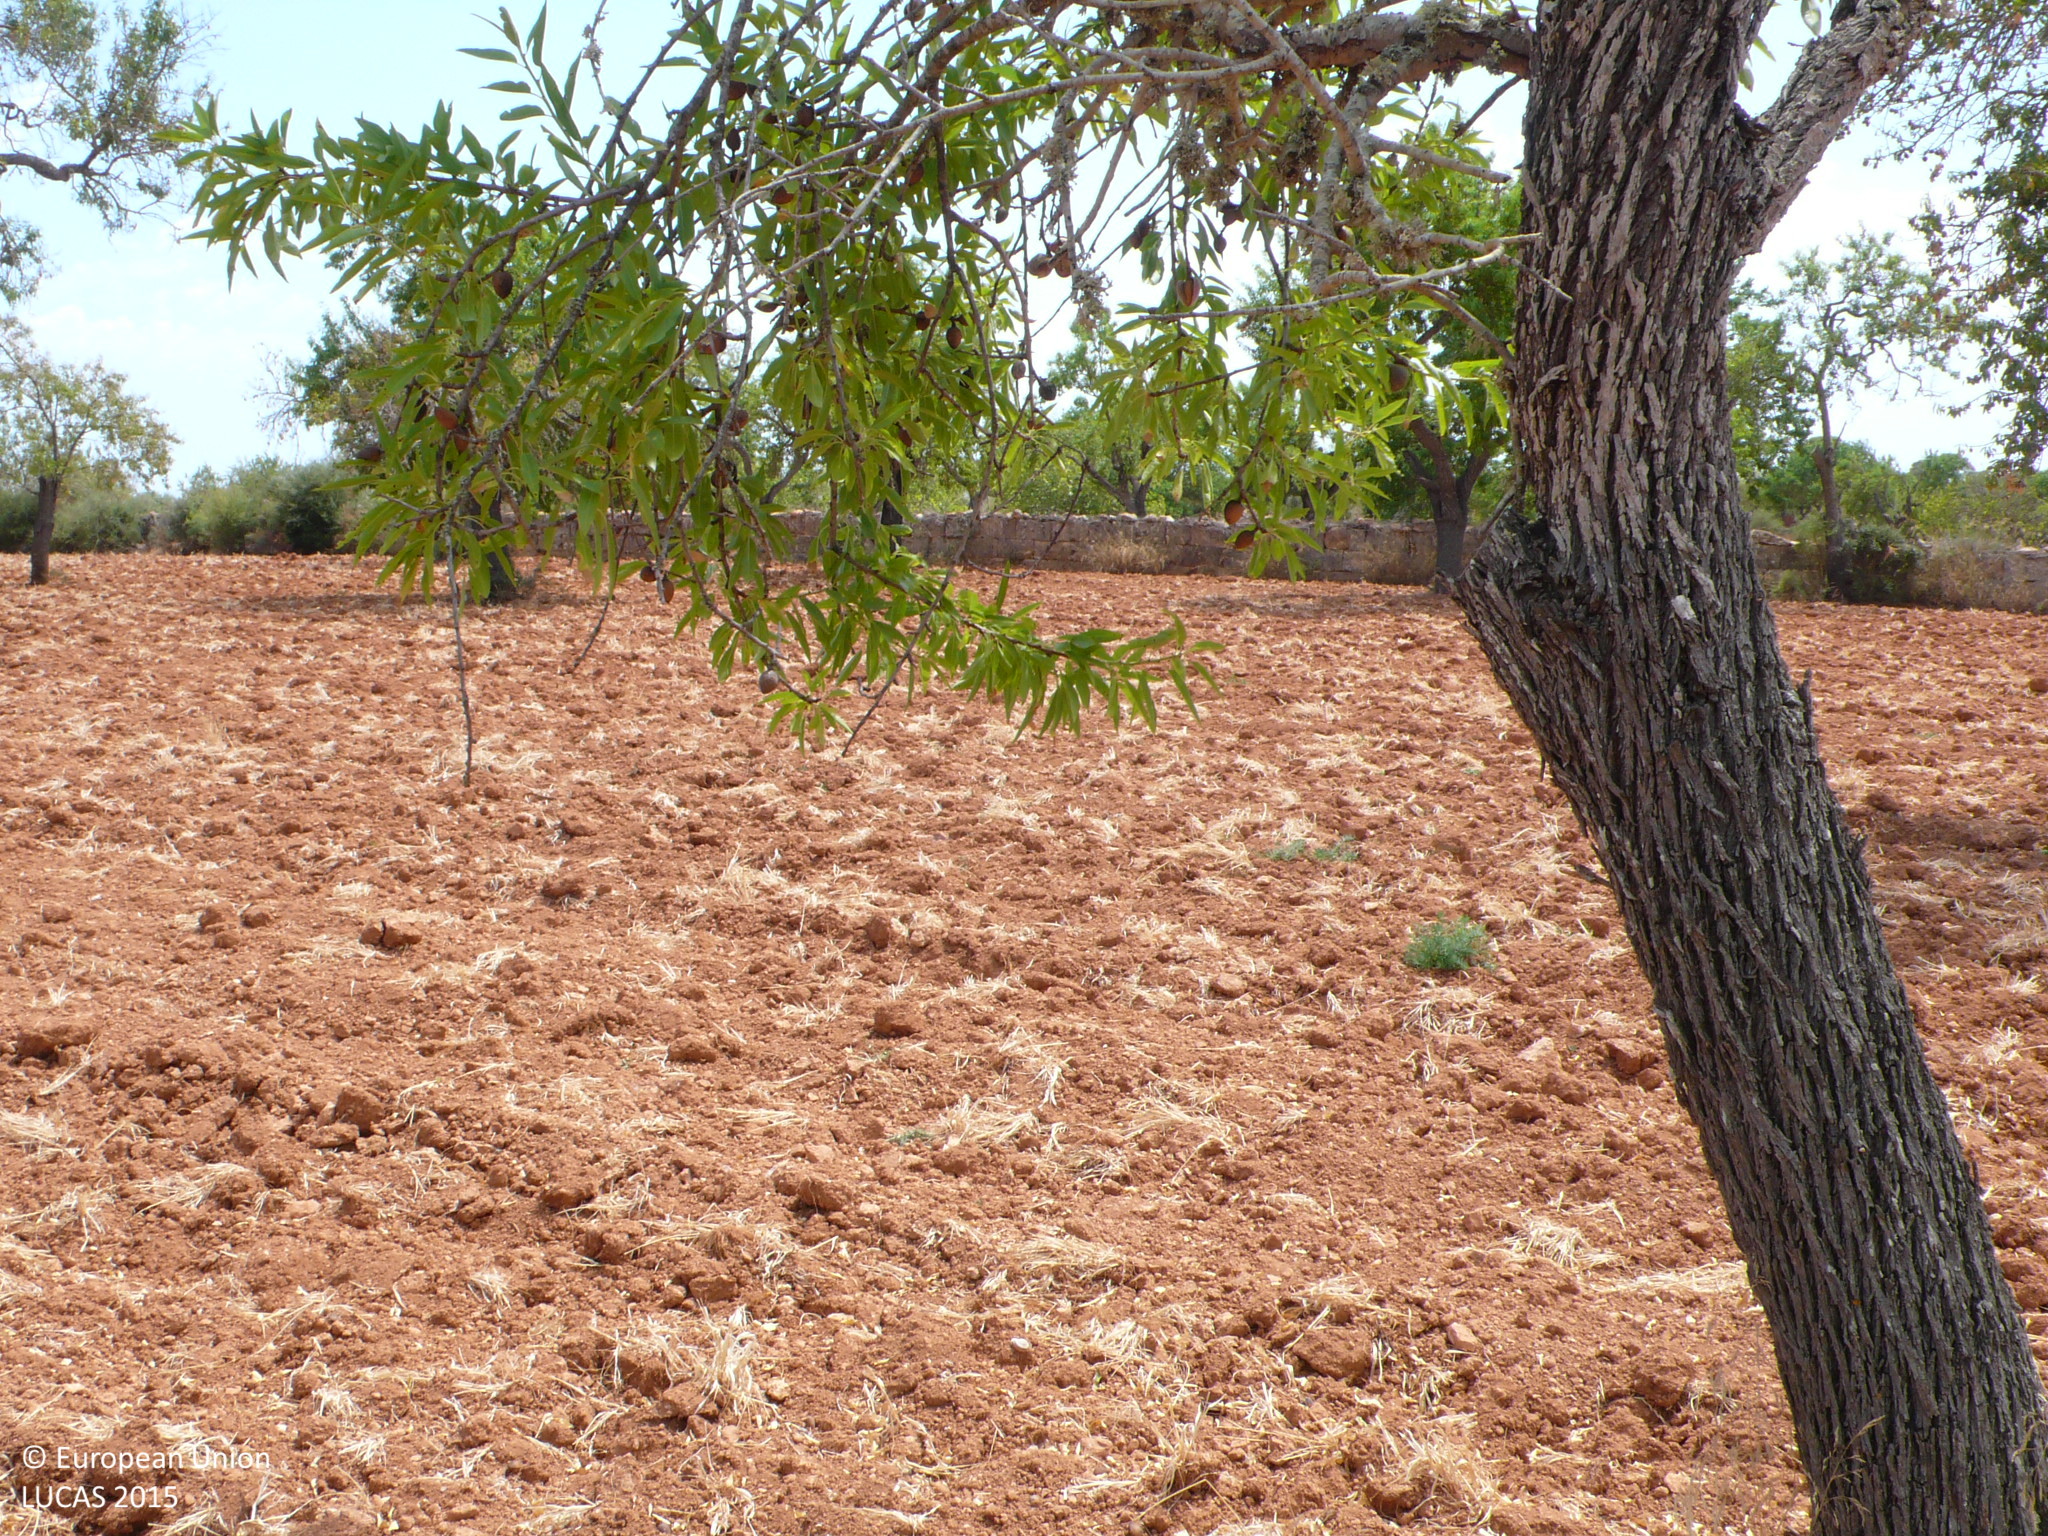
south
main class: Cropland
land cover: Nuts trees
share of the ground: 10 - 25 %
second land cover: Other bare soil
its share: > 75 %
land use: Agriculture (excluding fallow land and kitchen gardens)
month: July
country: ES
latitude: 39.4472
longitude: 2.9080
